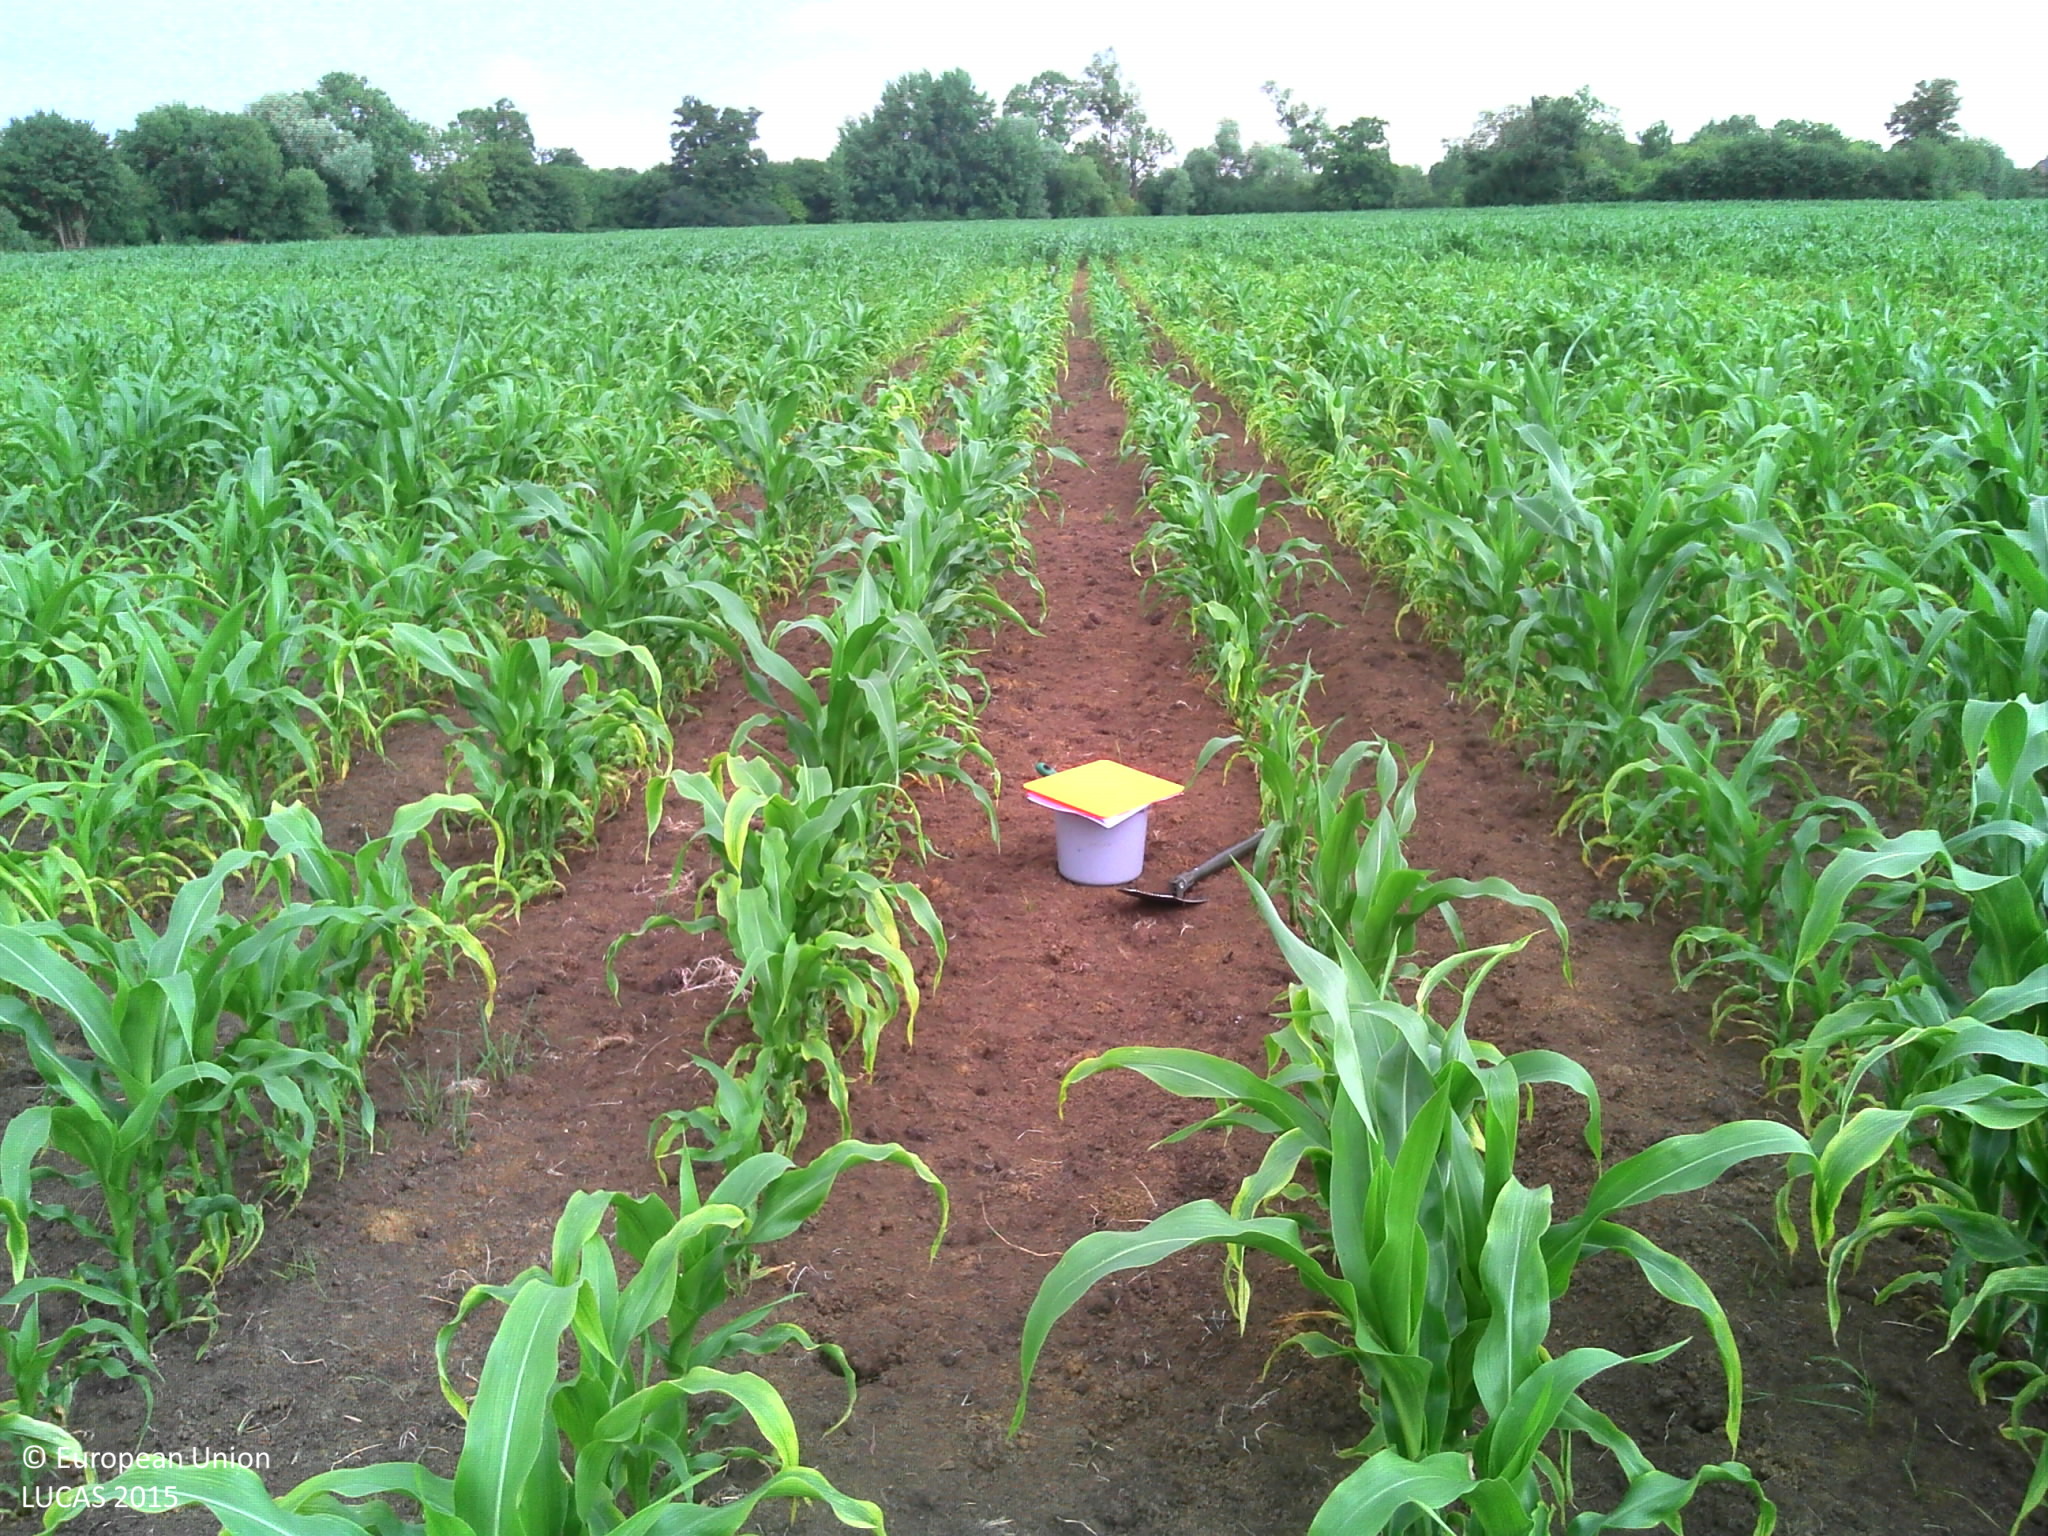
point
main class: Cropland
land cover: Maize
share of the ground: 25 - 50 %
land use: Agriculture (excluding fallow land and kitchen gardens)
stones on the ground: < 10 %
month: July
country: FR
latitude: 48.9297
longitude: 0.0191
